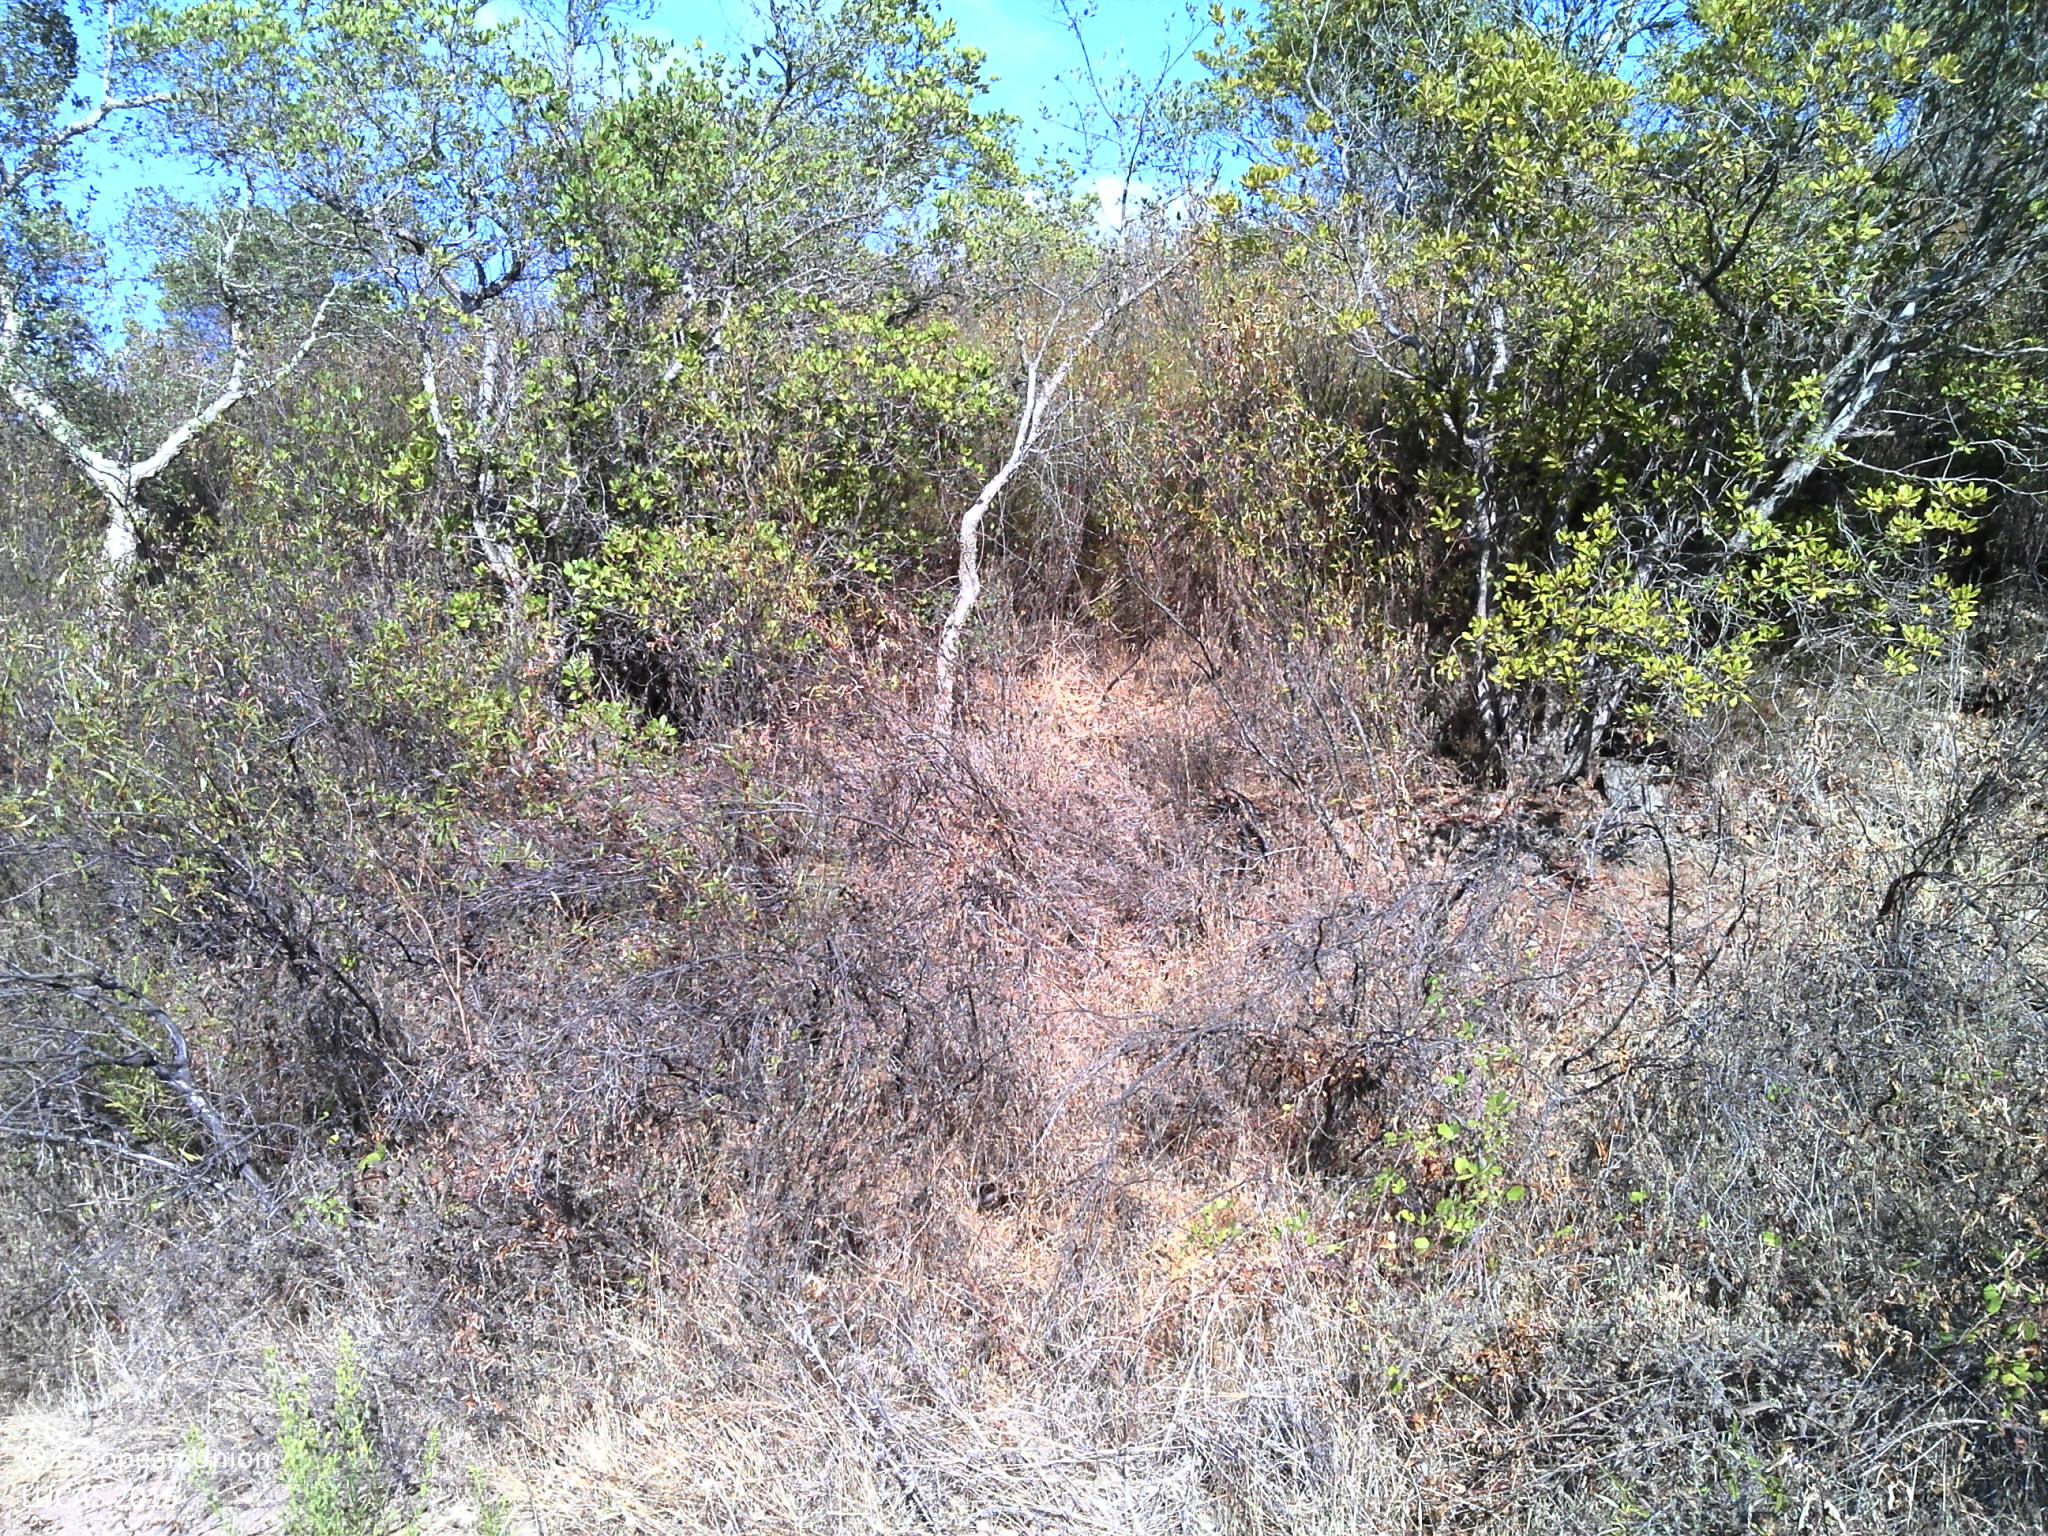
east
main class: Shrubland
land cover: Shrubland with sparse tree cover
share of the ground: 50 - 75 %
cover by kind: shrubs 70 %, unconsolidated bare surface 25 %, broadleaved forest trees 5 %
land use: Forestry
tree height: < 5 m
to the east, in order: Shrubland with sparse tree cover; Other structural elements; Broadleaved woodland; Tracks; Broadleaved woodland; Shrubland without tree cover; Tracks; Shrubland with sparse tree cover; Broadleaved woodland
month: September
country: PT
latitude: 37.3892
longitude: -8.4507
